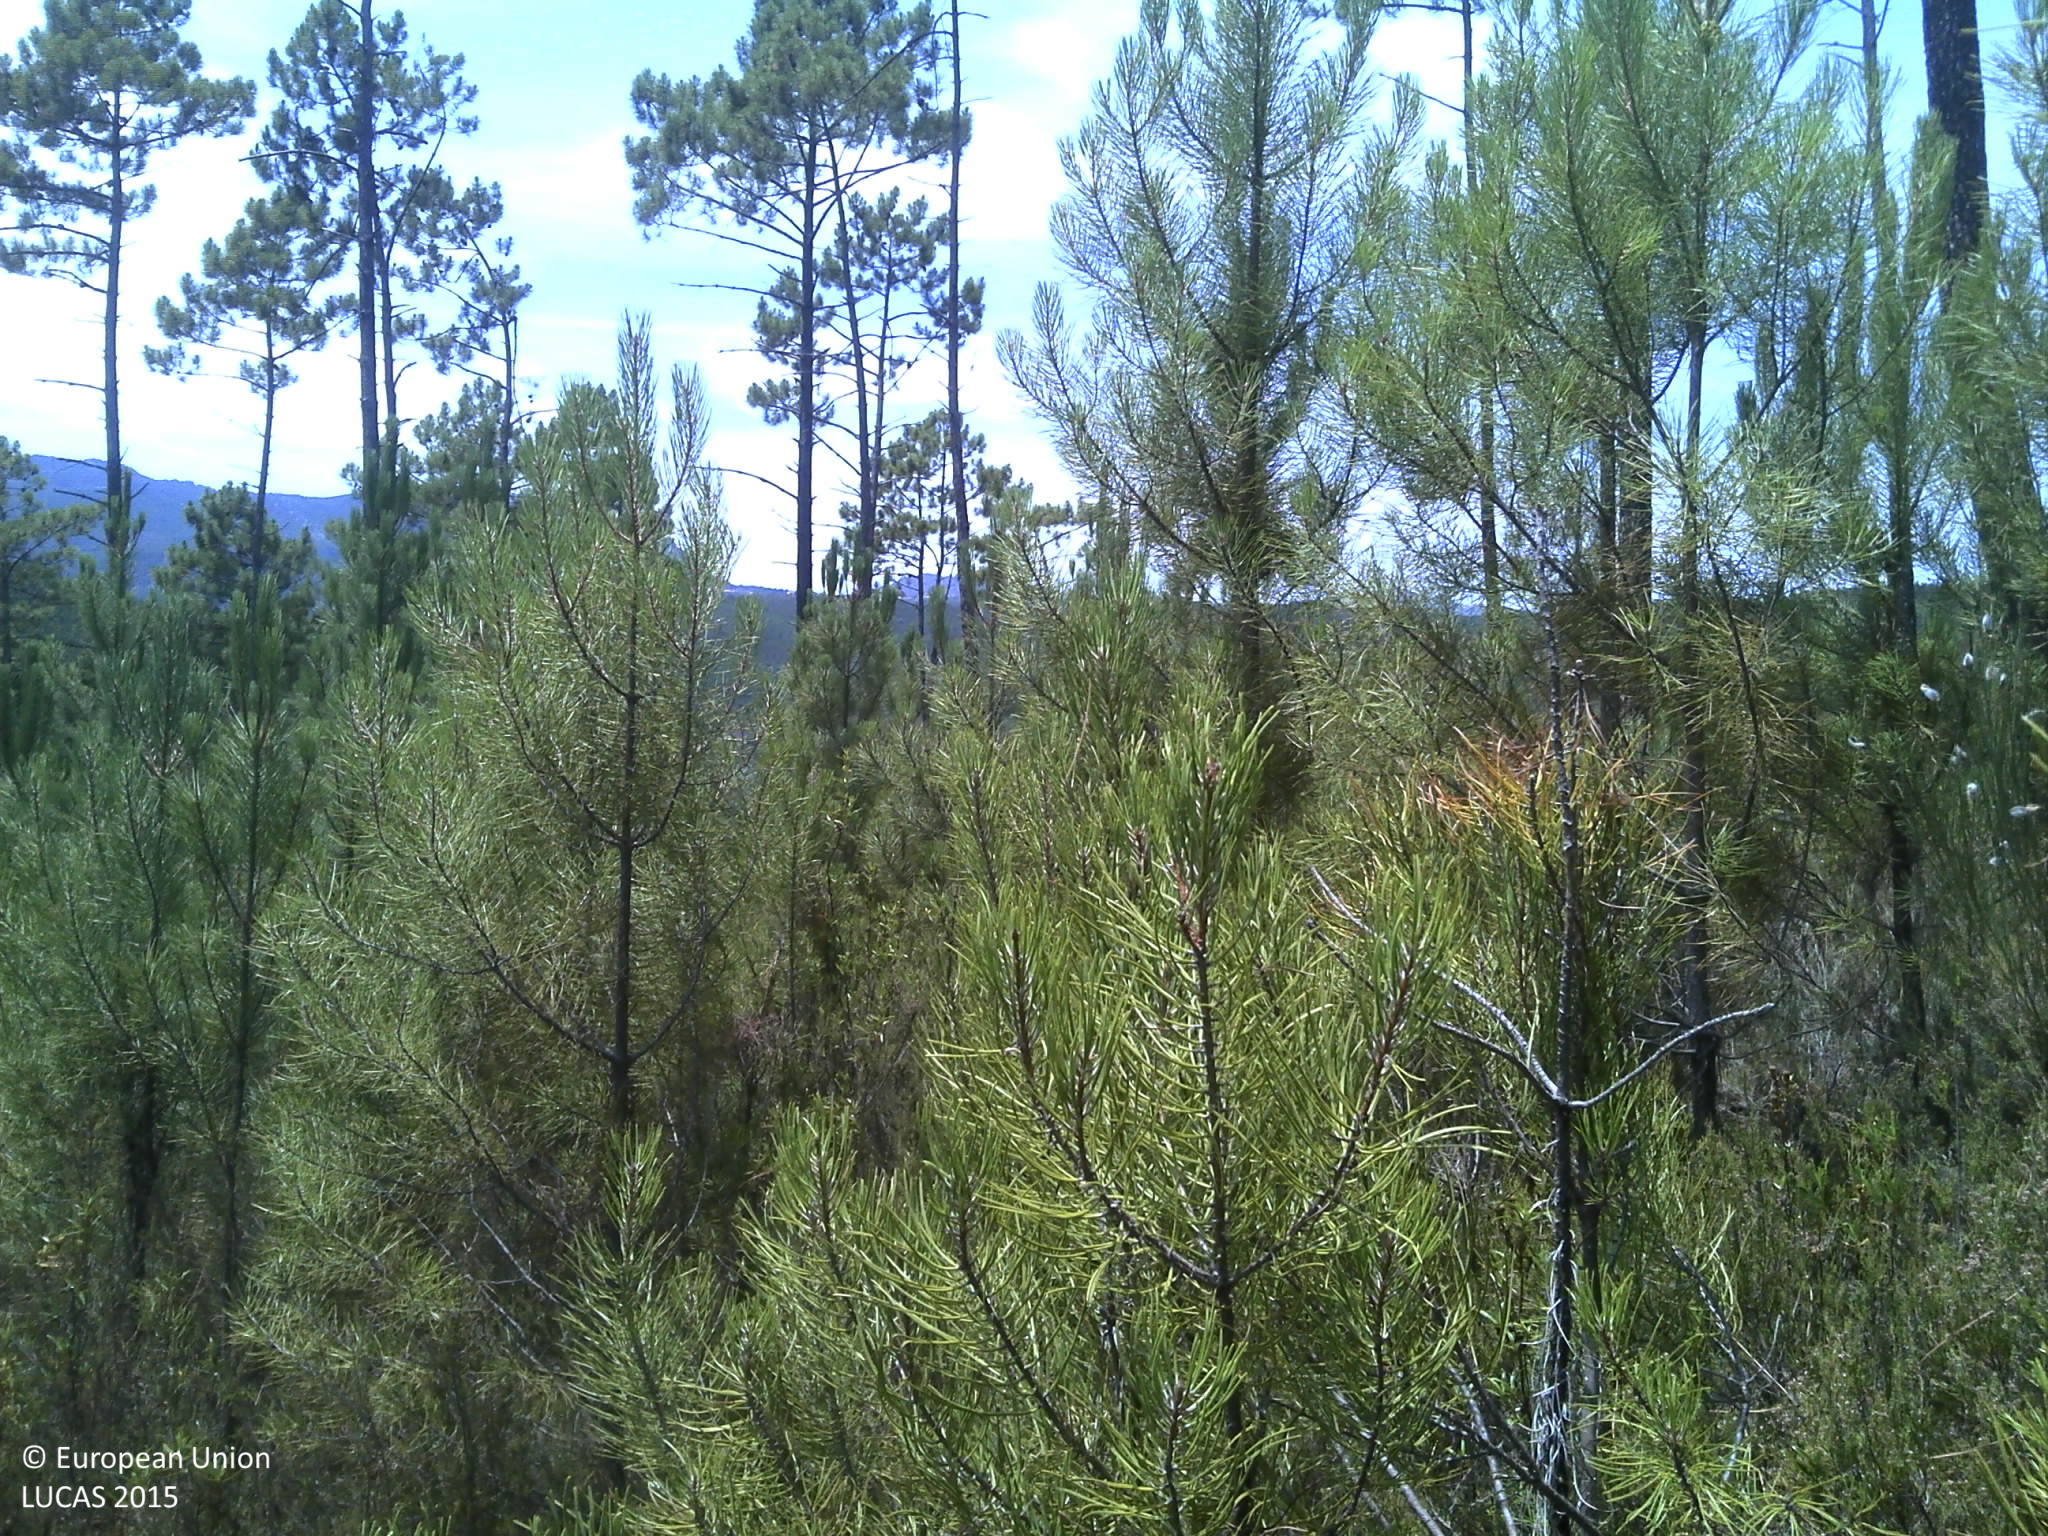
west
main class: Woodland
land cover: Pine dominated coniferous woodland
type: coniferous forest of the mediterranean region
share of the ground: 25 - 50 %
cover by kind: coniferous forest trees 50 %, shrubs 30 %, unconsolidated bare surface 20 %
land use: Forestry
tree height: < 5 m
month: July
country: PT
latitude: 40.0867
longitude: -7.7853
